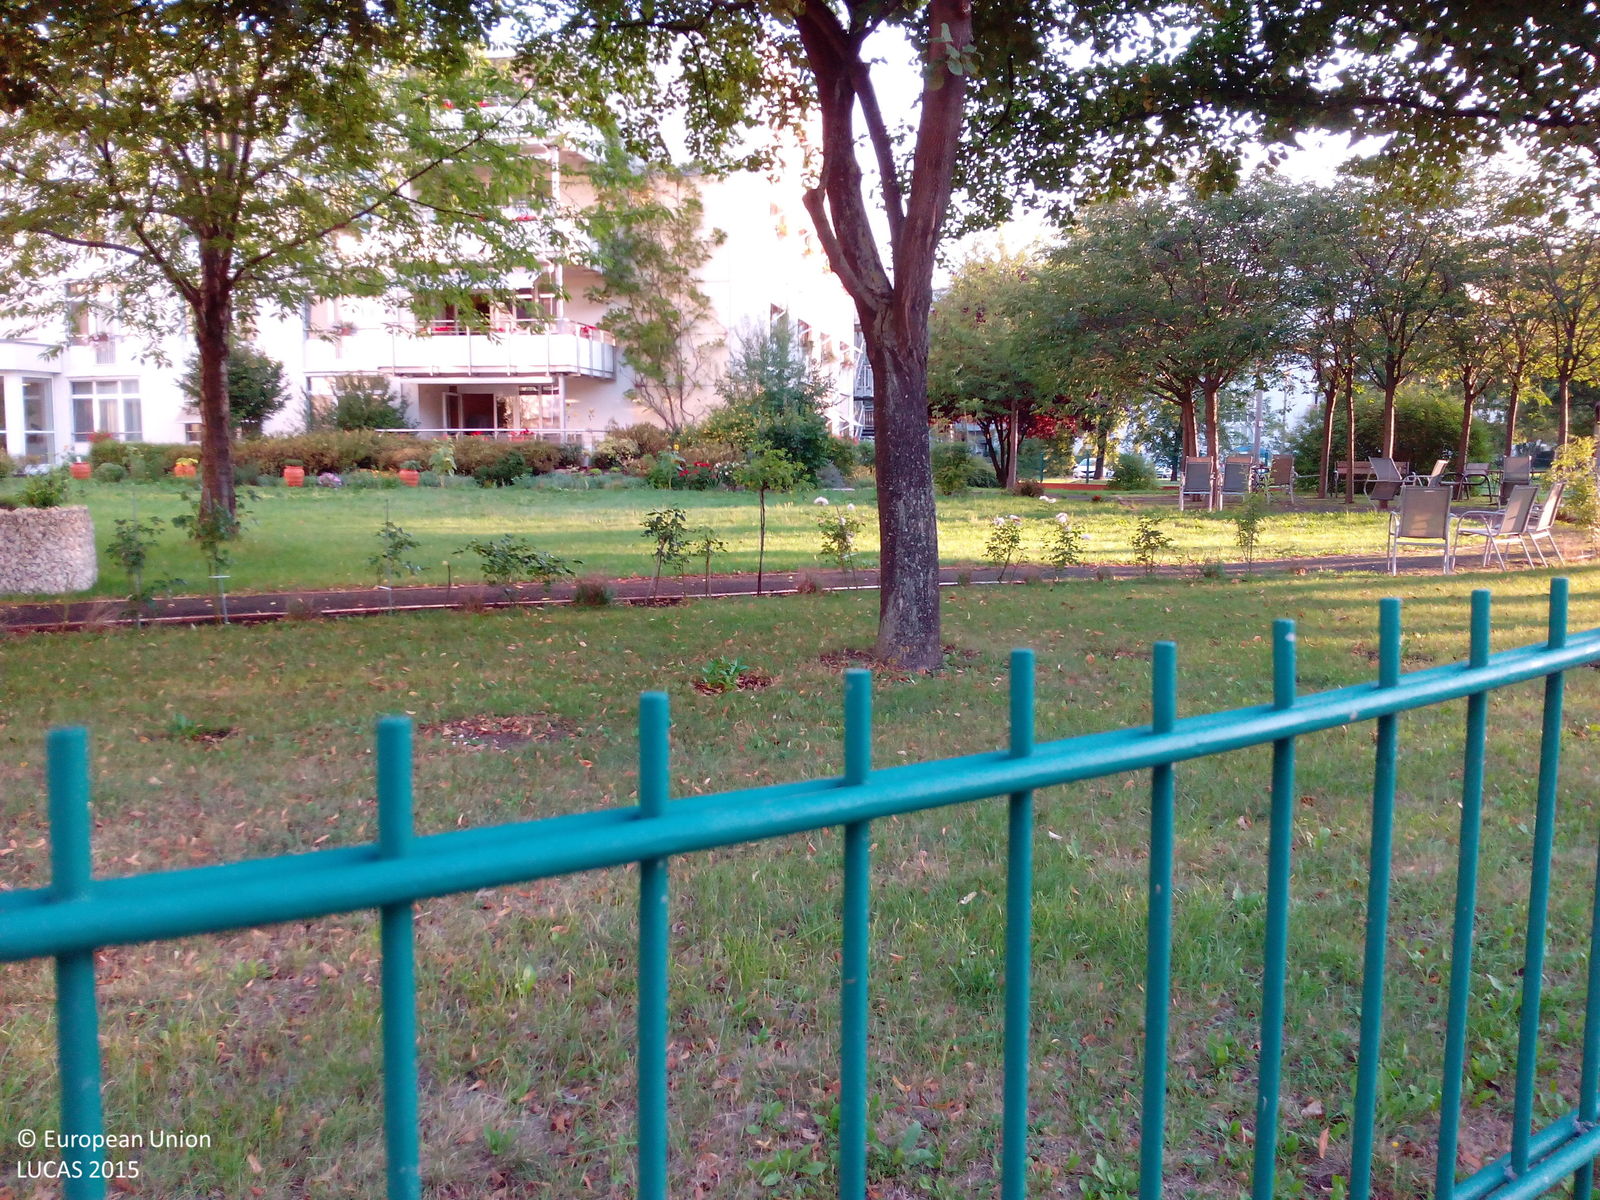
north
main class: Woodland
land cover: Broadleaved woodland
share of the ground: 25 - 50 %
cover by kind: herbaceous plants 45 %, broadleaved forest trees 40 %, consolidated bare surface 10 %, shrubs 5 %
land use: Residential
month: August
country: DE
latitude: 51.0069
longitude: 11.0116
